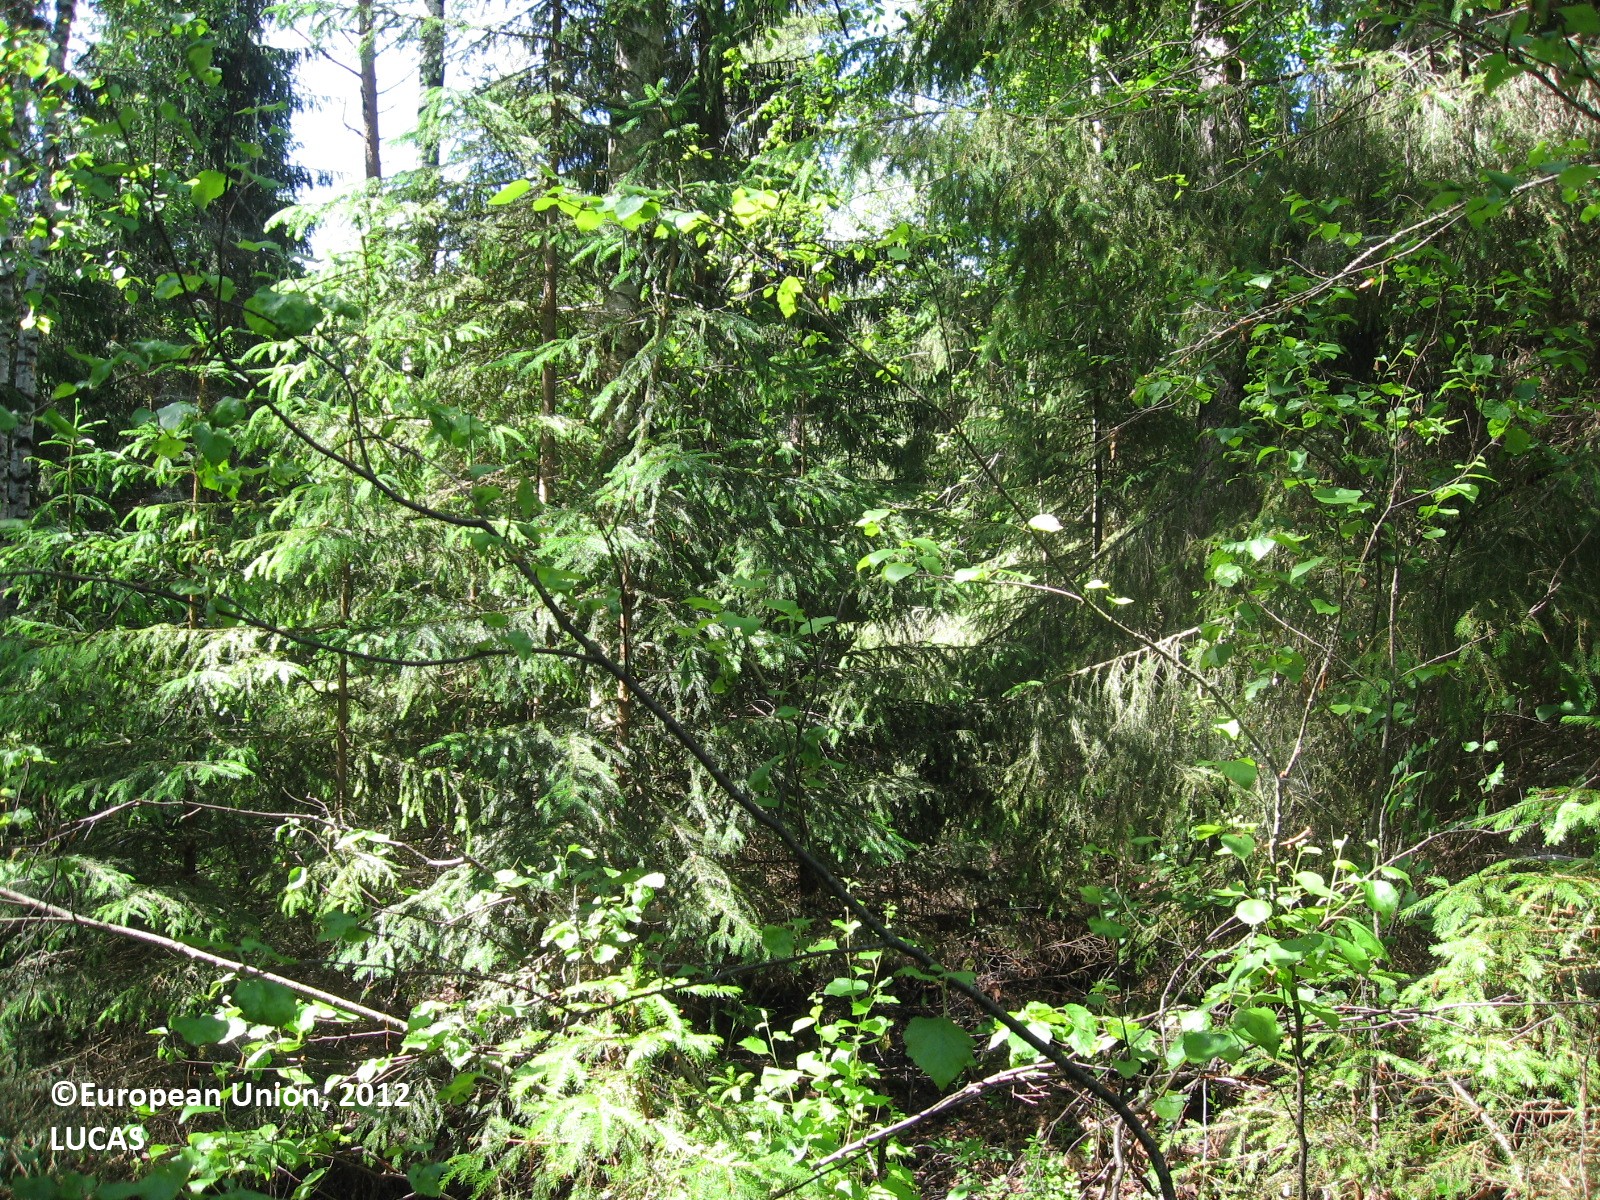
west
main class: Woodland
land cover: Other coniferous woodland
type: boreal forest
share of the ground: 50 - 75 %
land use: Forestry
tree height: > 5 m
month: June
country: FI
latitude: 60.5266
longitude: 26.3495
